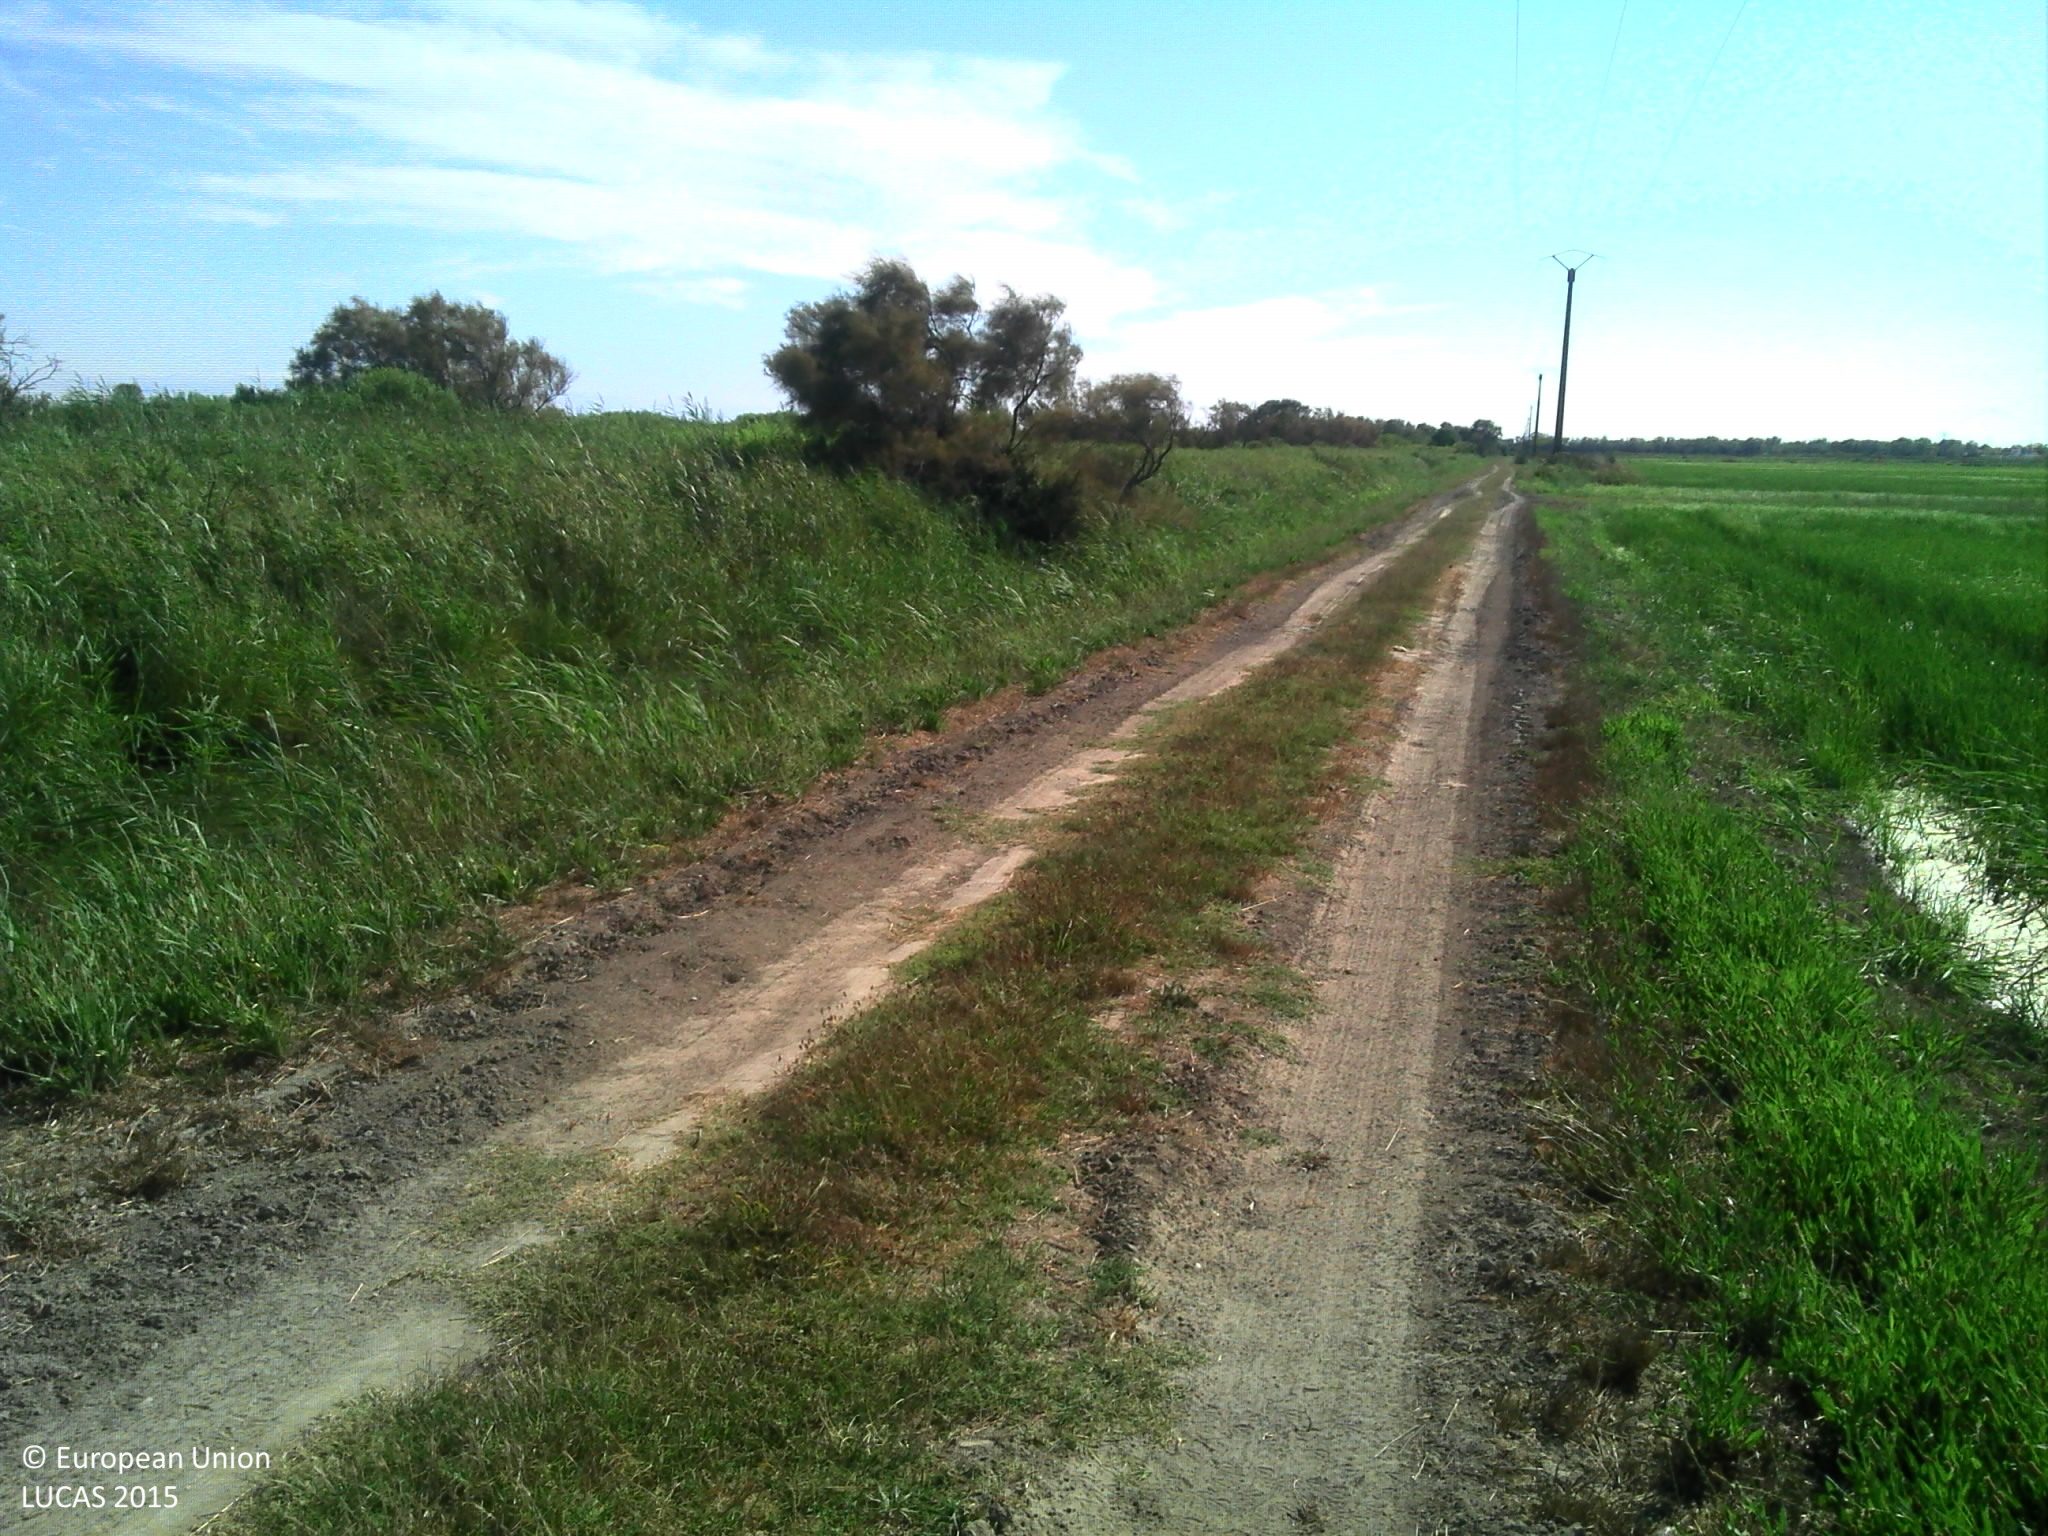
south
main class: Cropland
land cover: Rice
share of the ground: > 75 %
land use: Agriculture (excluding fallow land and kitchen gardens)
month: July
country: FR
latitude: 43.4228
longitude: 4.7608
